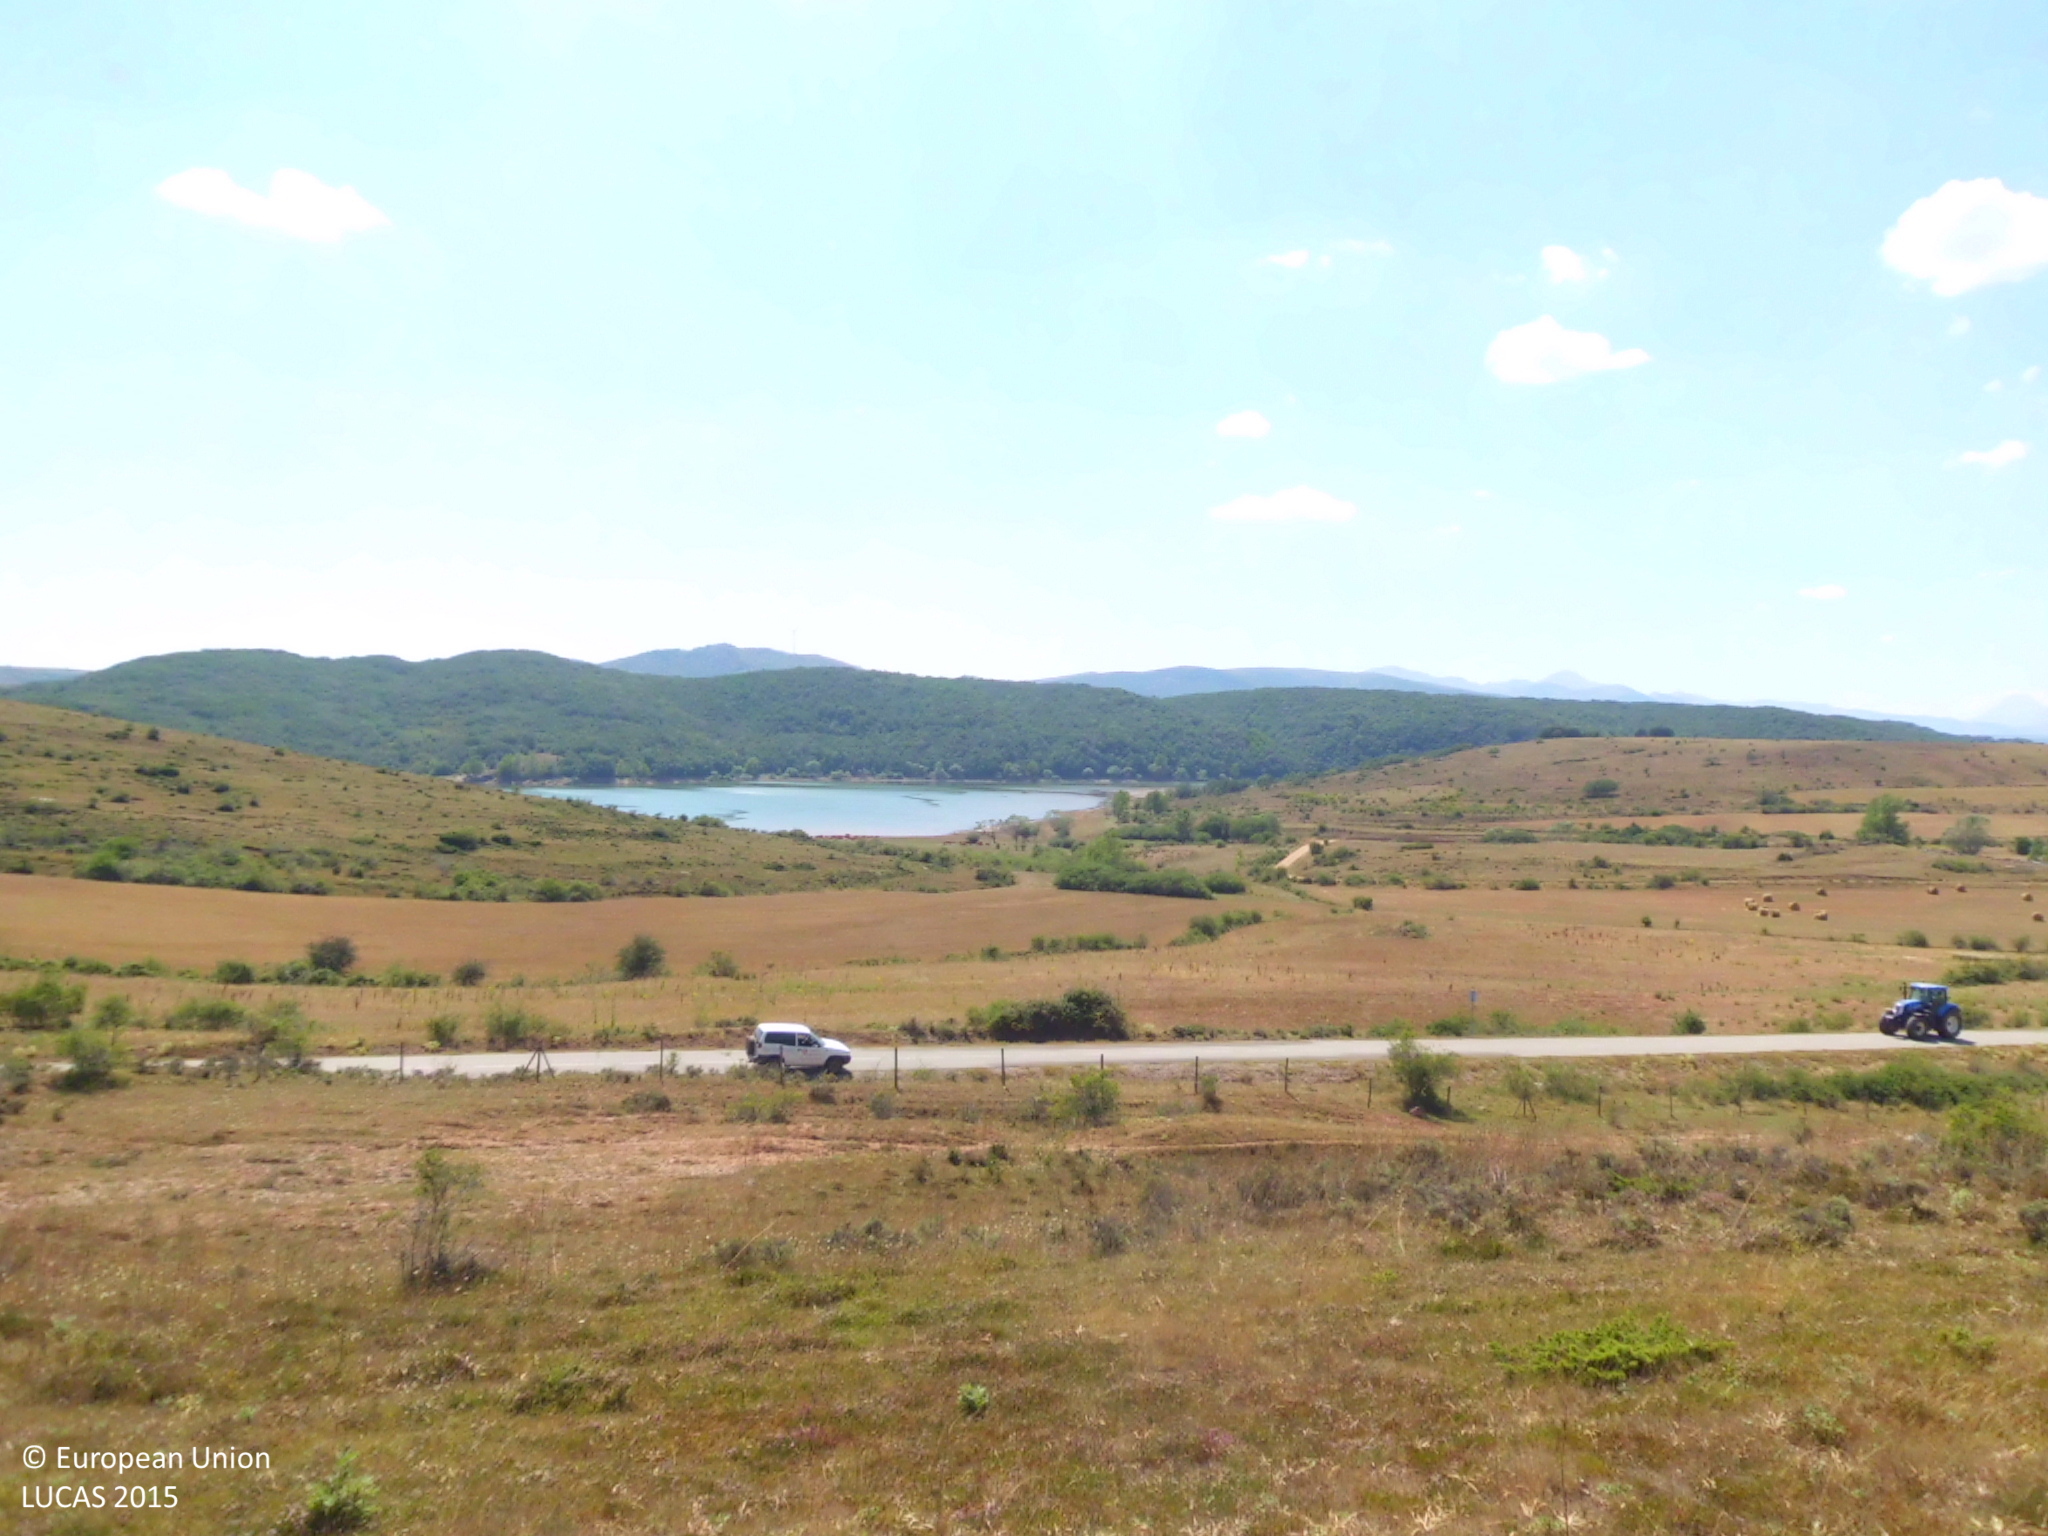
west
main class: Grassland
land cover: Grassland without tree/shrub cover
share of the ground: > 75 %
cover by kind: herbaceous plants 95 %, shrubs 5 %
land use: Agriculture (excluding fallow land and kitchen gardens)
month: July
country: ES
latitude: 42.8342
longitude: -4.3535
